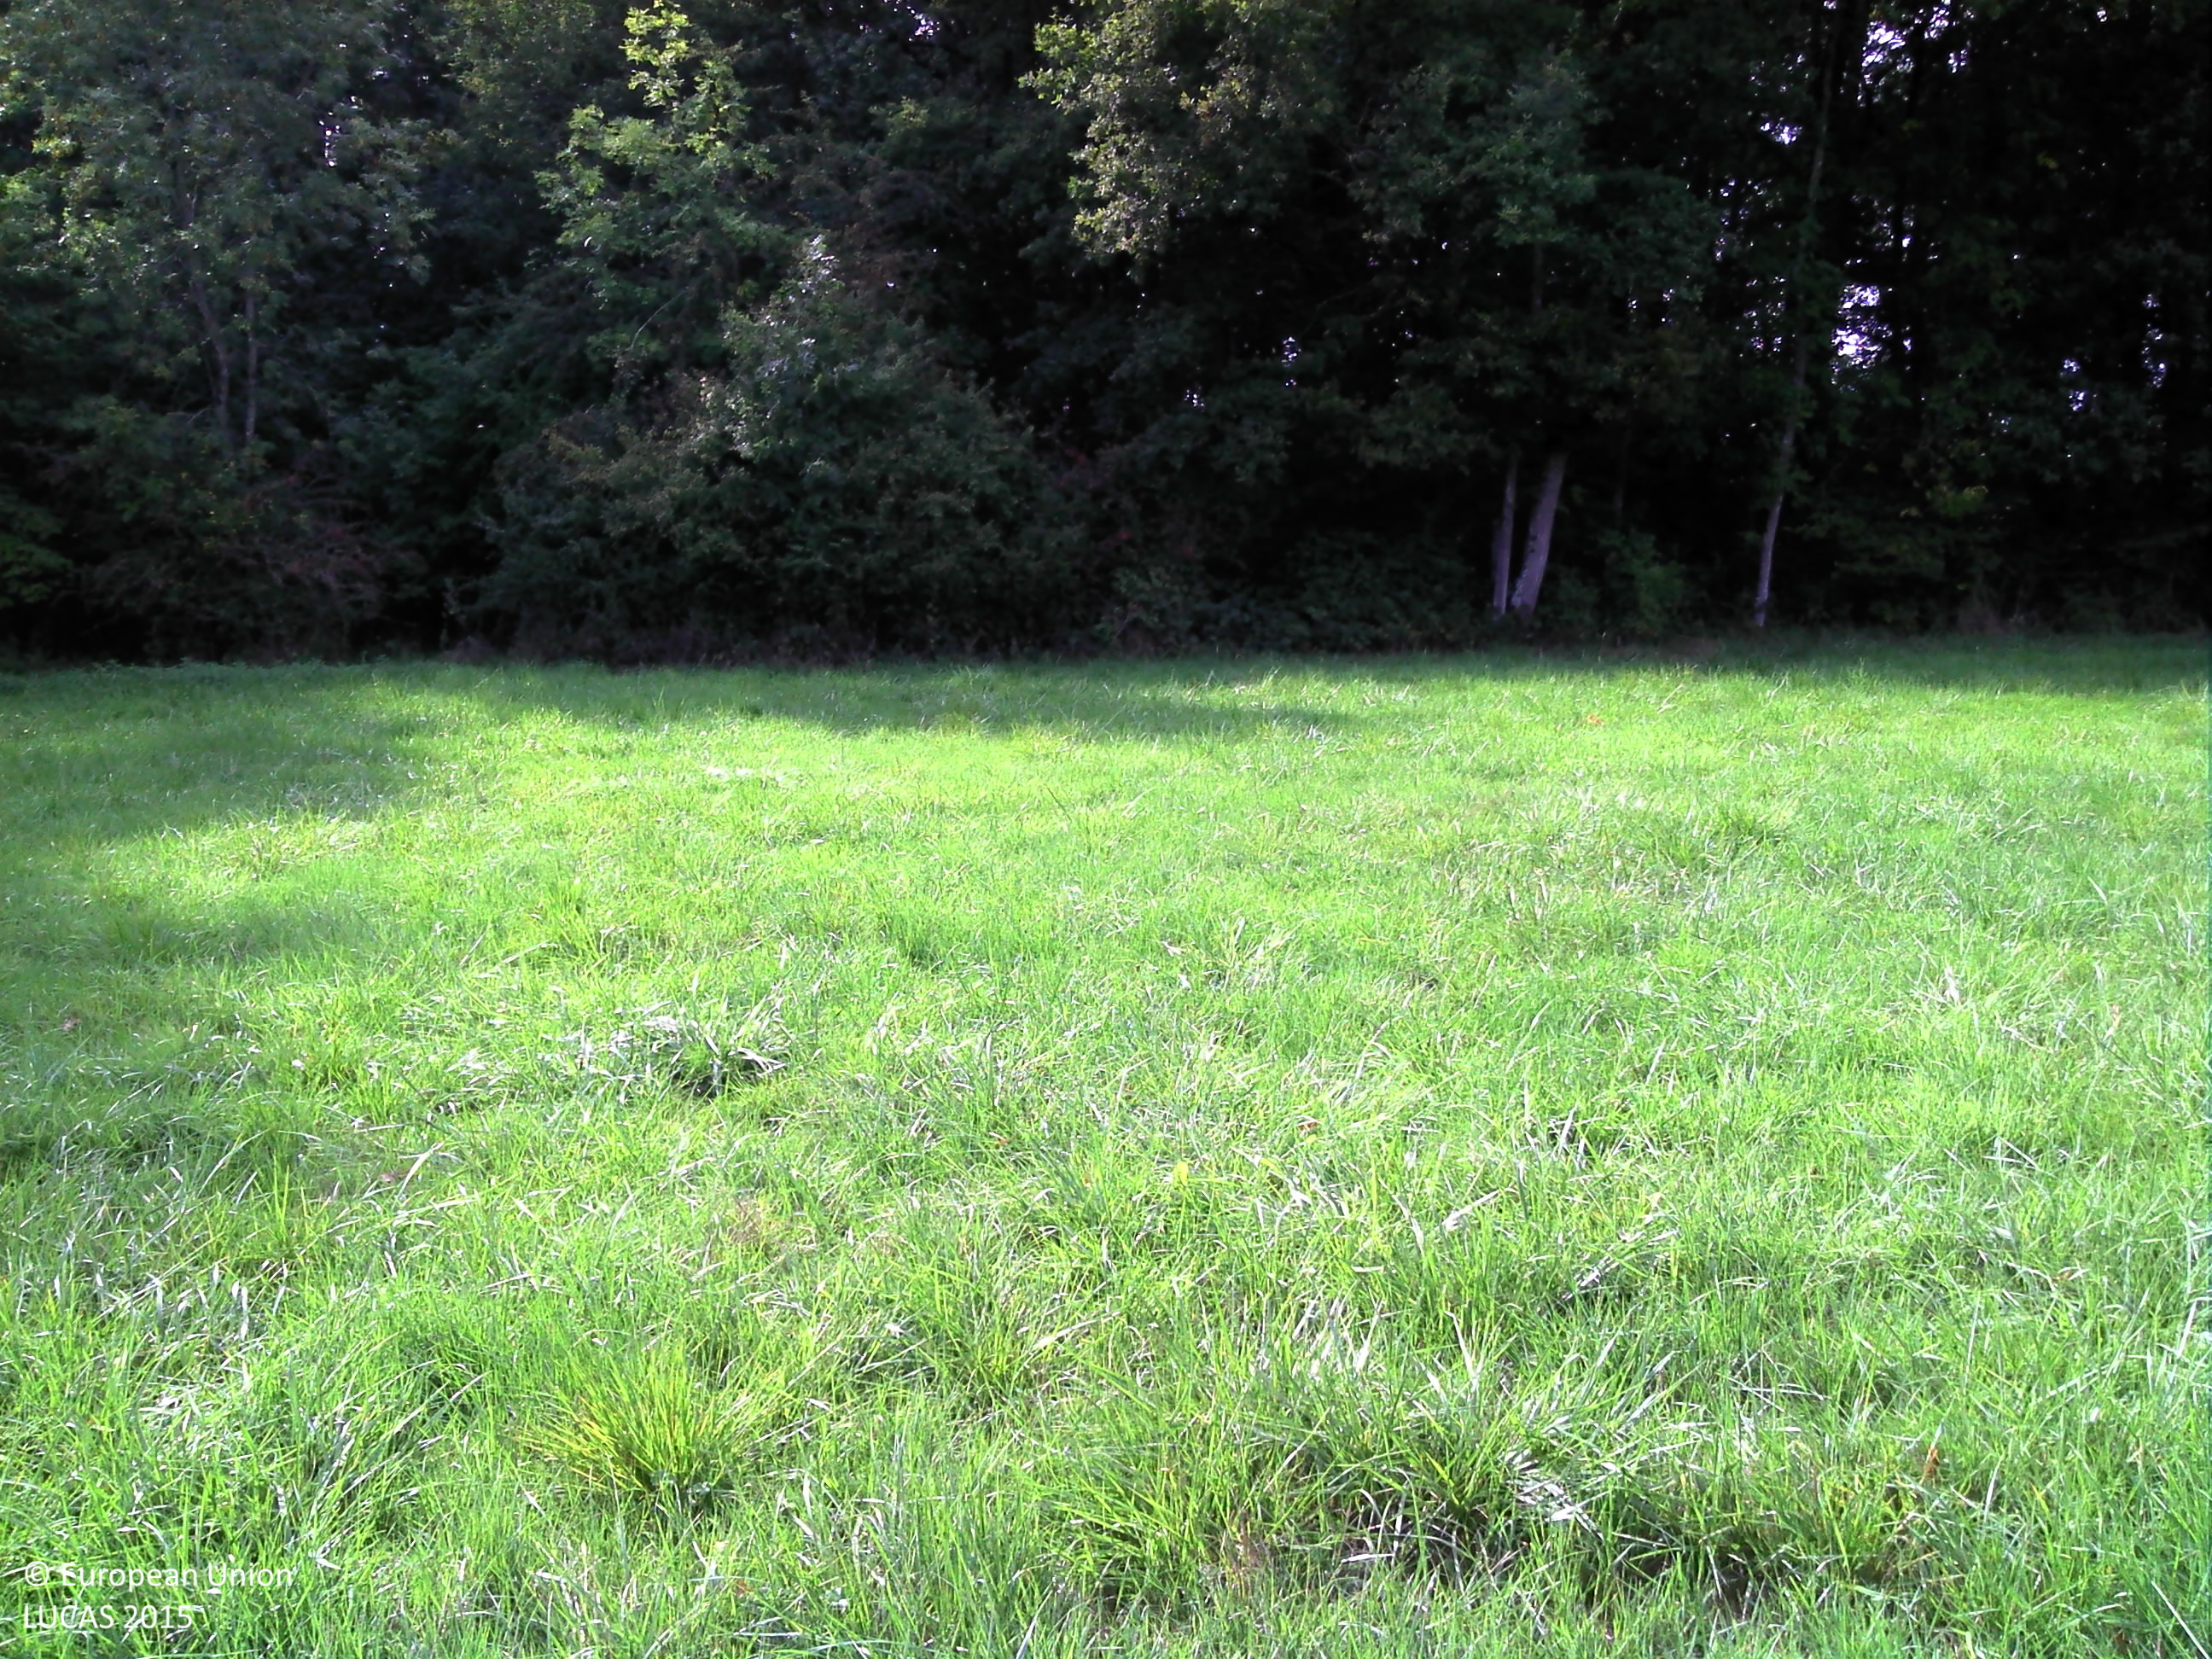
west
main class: Grassland
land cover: Grassland without tree/shrub cover
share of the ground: > 75 %
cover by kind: herbaceous plants 100 %
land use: Agriculture (excluding fallow land and kitchen gardens)
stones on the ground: < 10 %
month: September
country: FR
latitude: 48.5072
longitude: 4.6239
